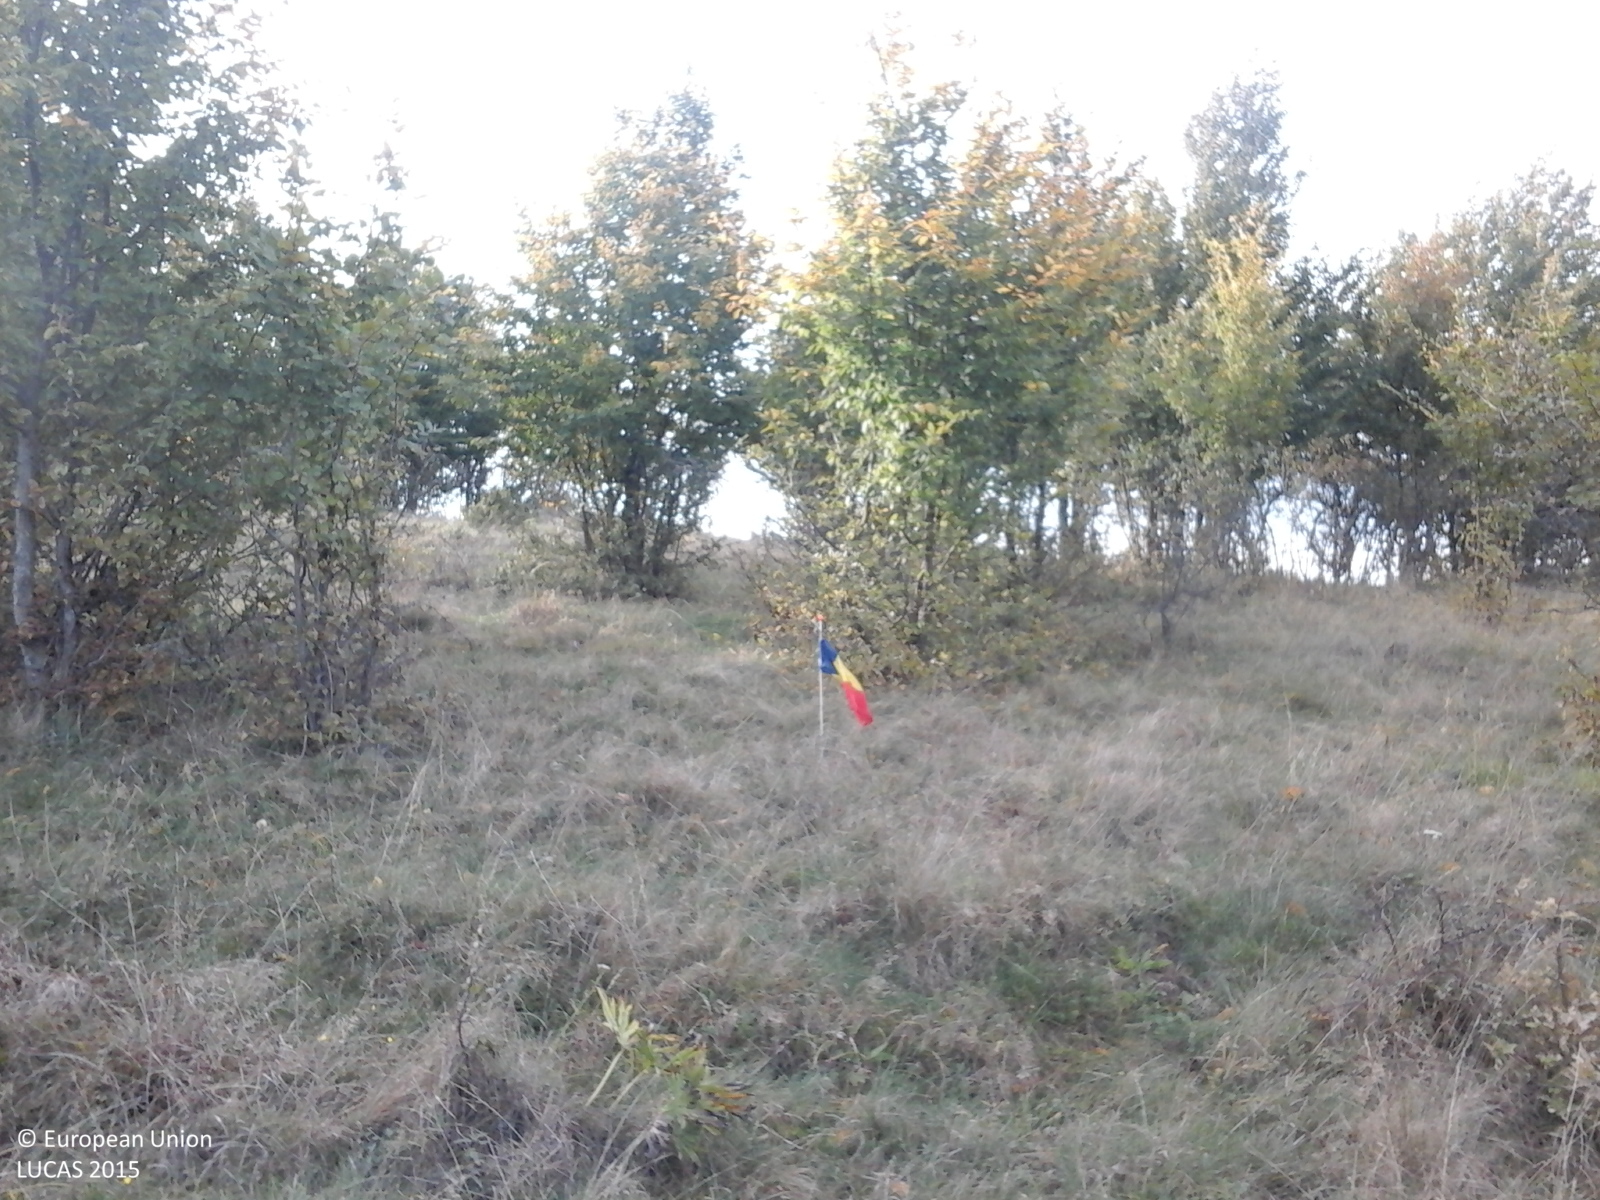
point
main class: Grassland
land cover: Grassland with sparse tree/shrub cover
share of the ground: > 75 %
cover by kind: herbaceous plants 85 %, shrubs 10 %, broadleaved forest trees 5 %
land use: Fallow land
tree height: < 5 m
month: October
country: RO
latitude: 46.2020
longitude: 25.2507
